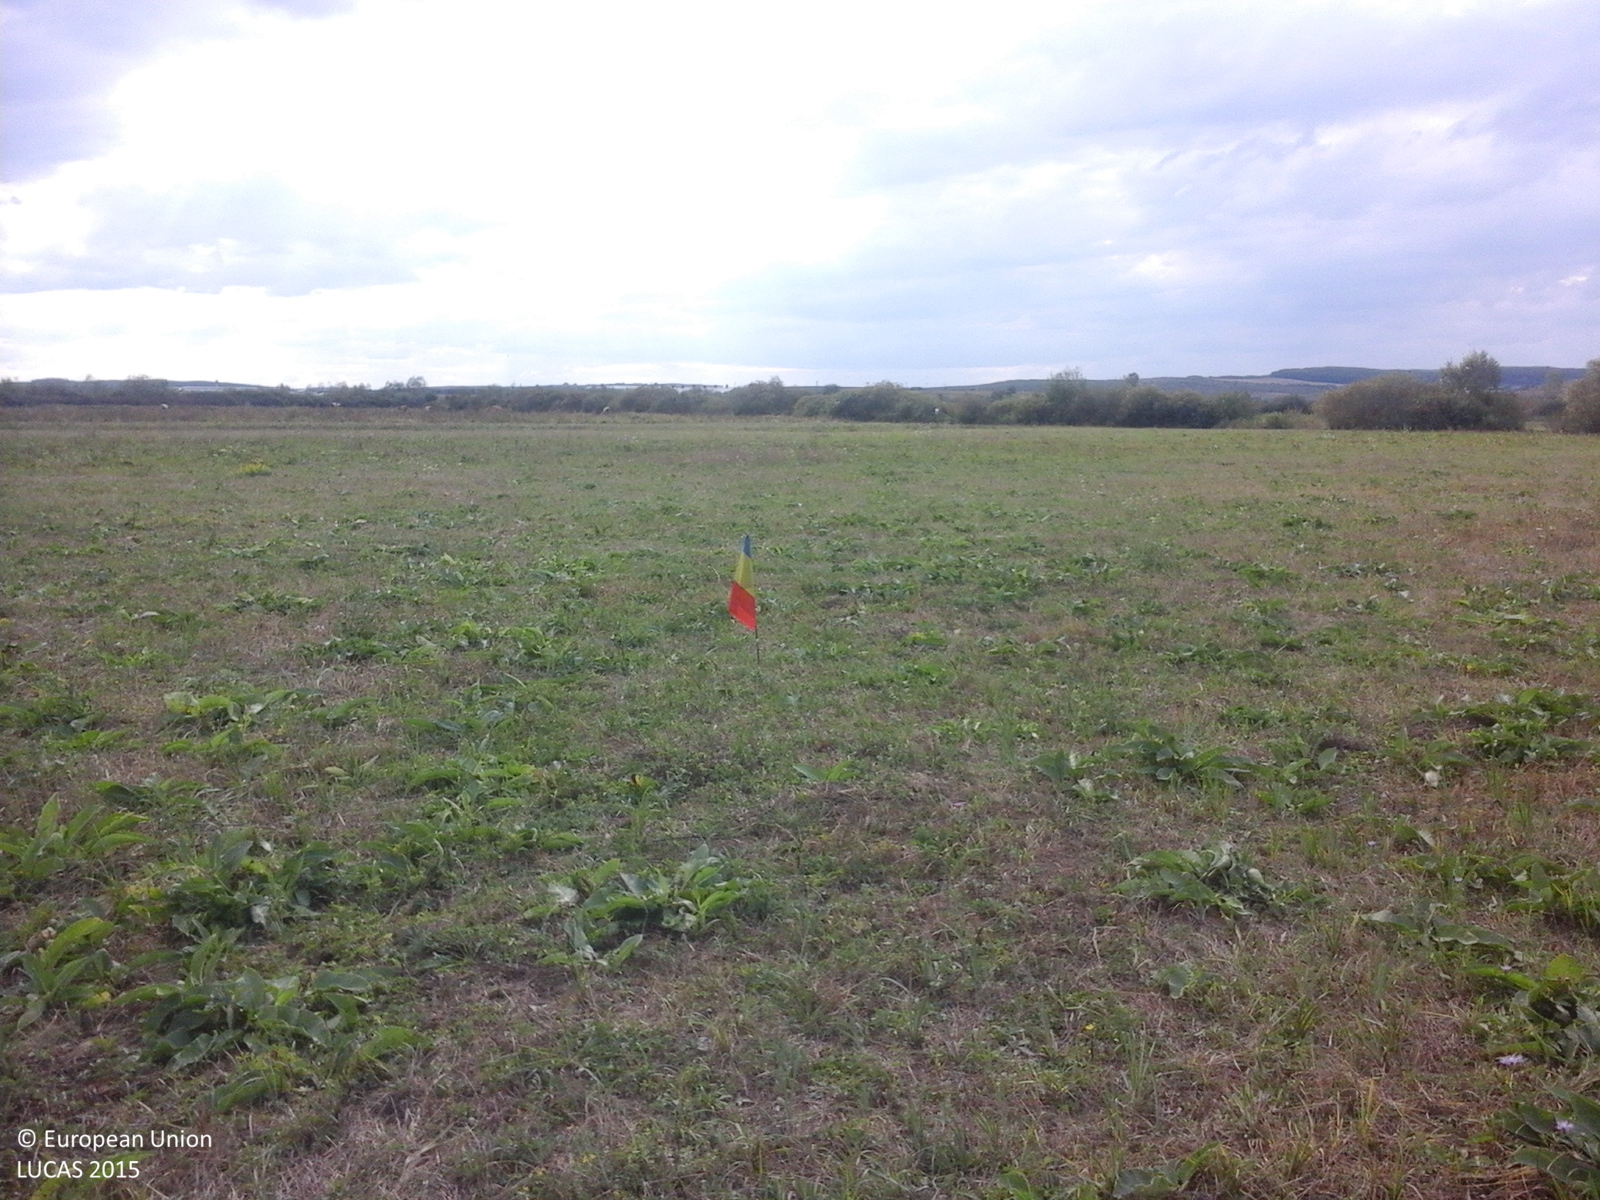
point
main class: Grassland
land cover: Grassland without tree/shrub cover
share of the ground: > 75 %
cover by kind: herbaceous plants 100 %
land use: Agriculture (excluding fallow land and kitchen gardens)
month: September
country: RO
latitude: 47.4635
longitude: 23.1882
